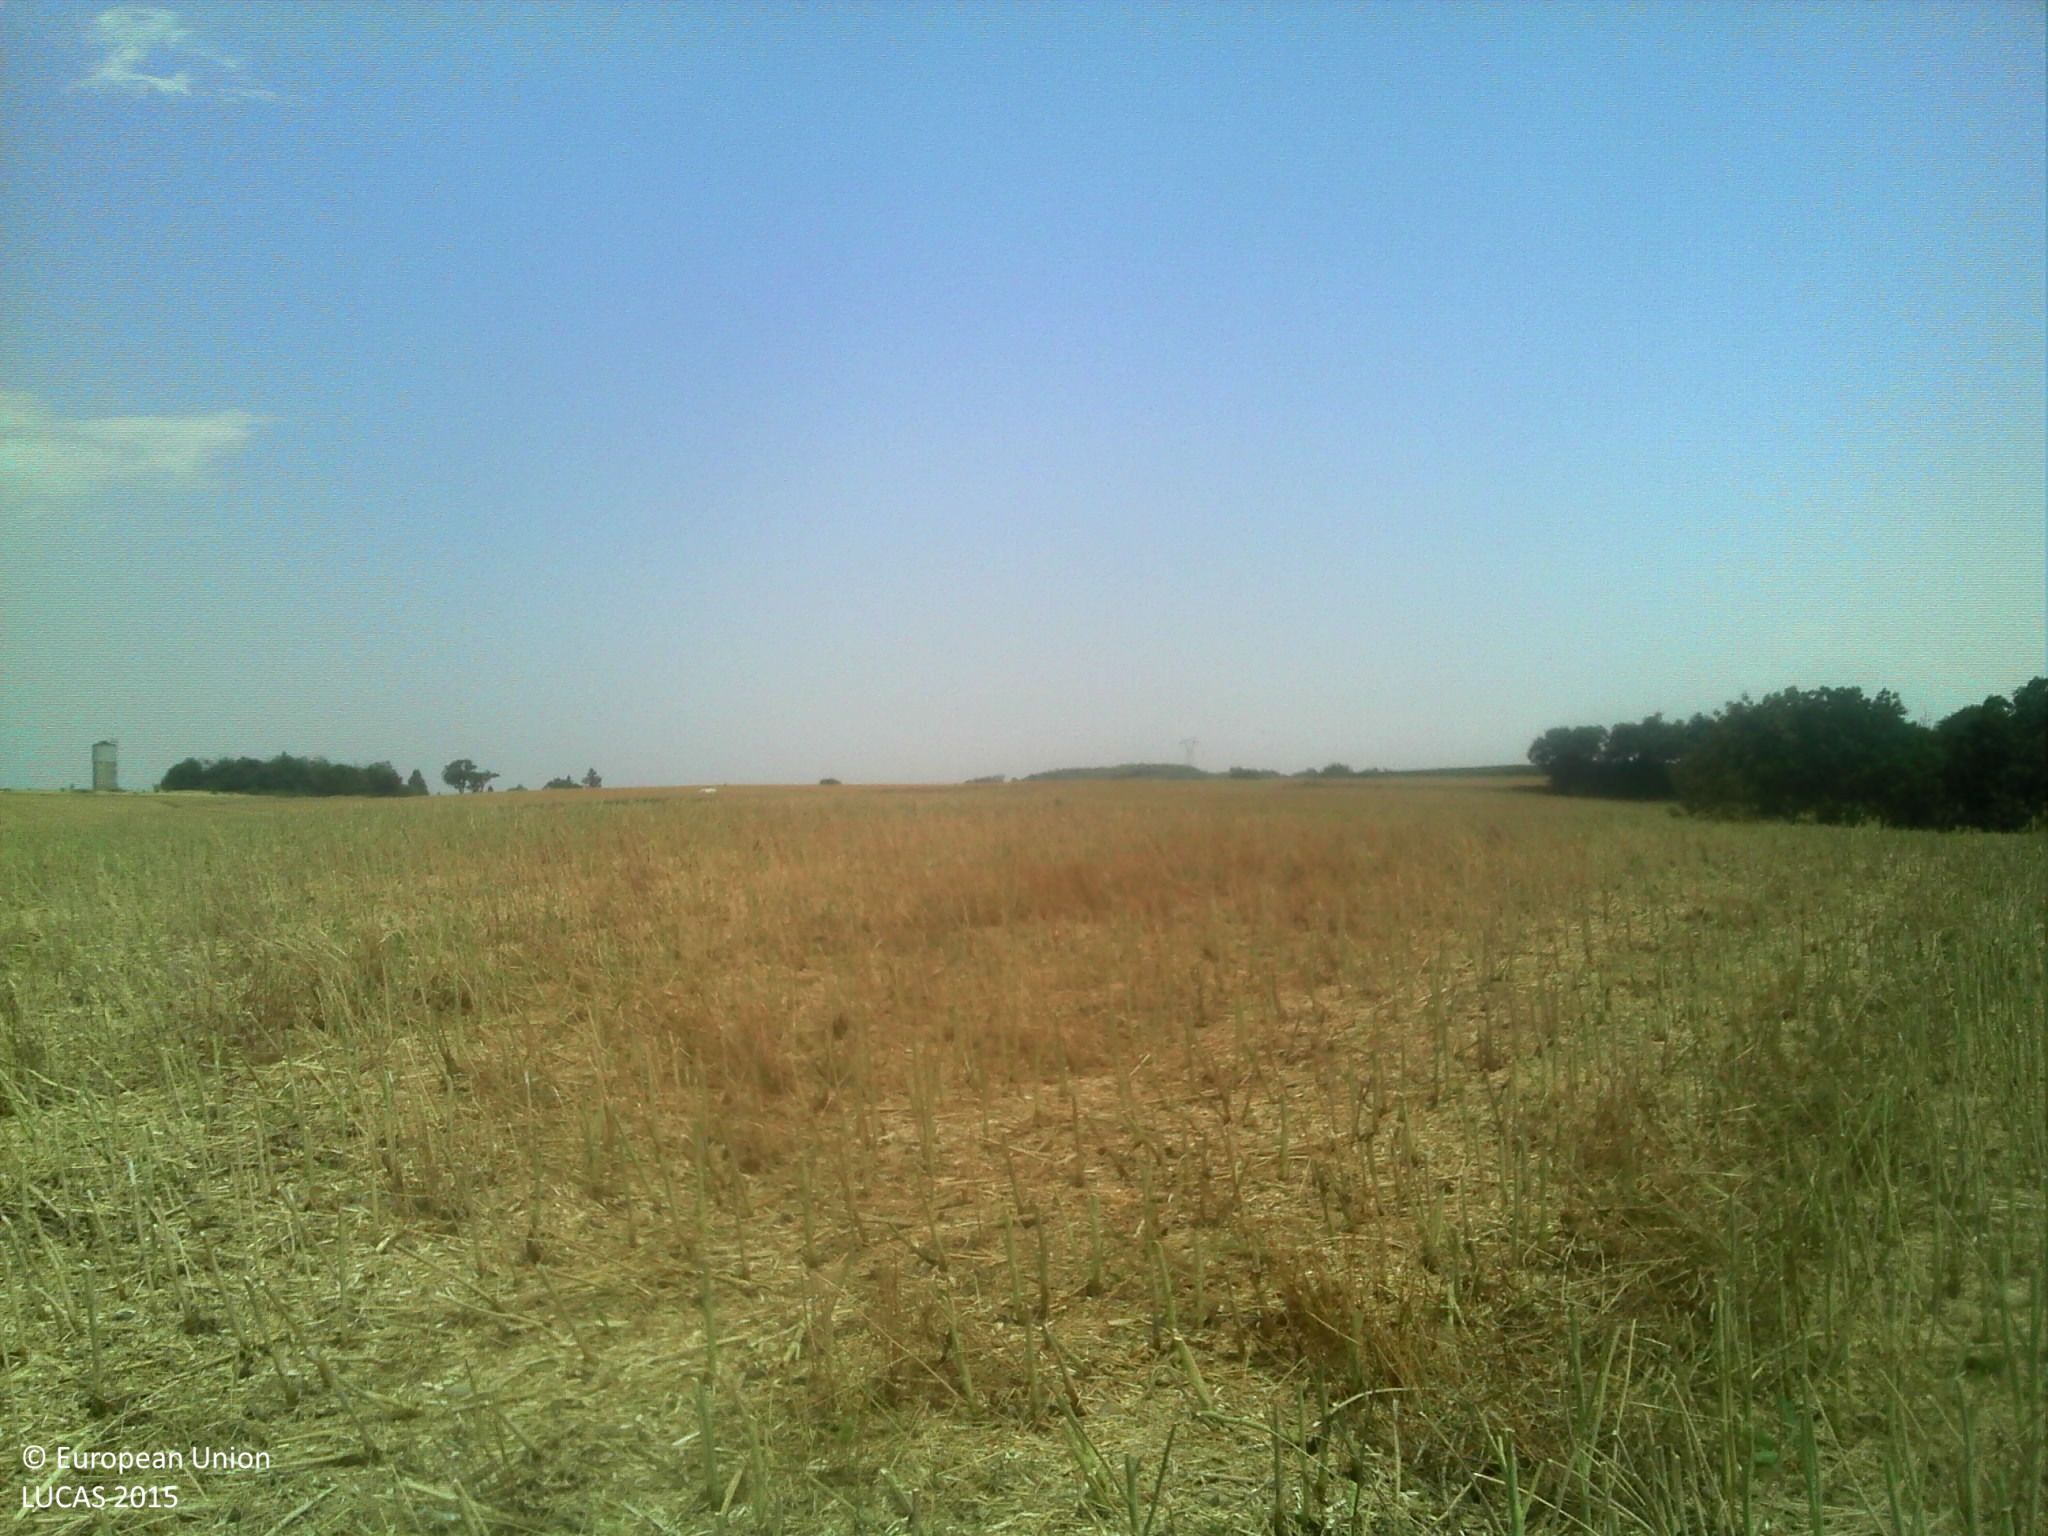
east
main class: Cropland
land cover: Rape and turnip rape
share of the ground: > 75 %
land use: Agriculture (excluding fallow land and kitchen gardens)
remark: Harvested field
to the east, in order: Rape and turnip rape; Grass margins; Rape and turnip rape; Grass margins; Tracks; Grass margins; Barley; Rape and turnip rape
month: July
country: FR
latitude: 45.5554
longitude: 5.1493
